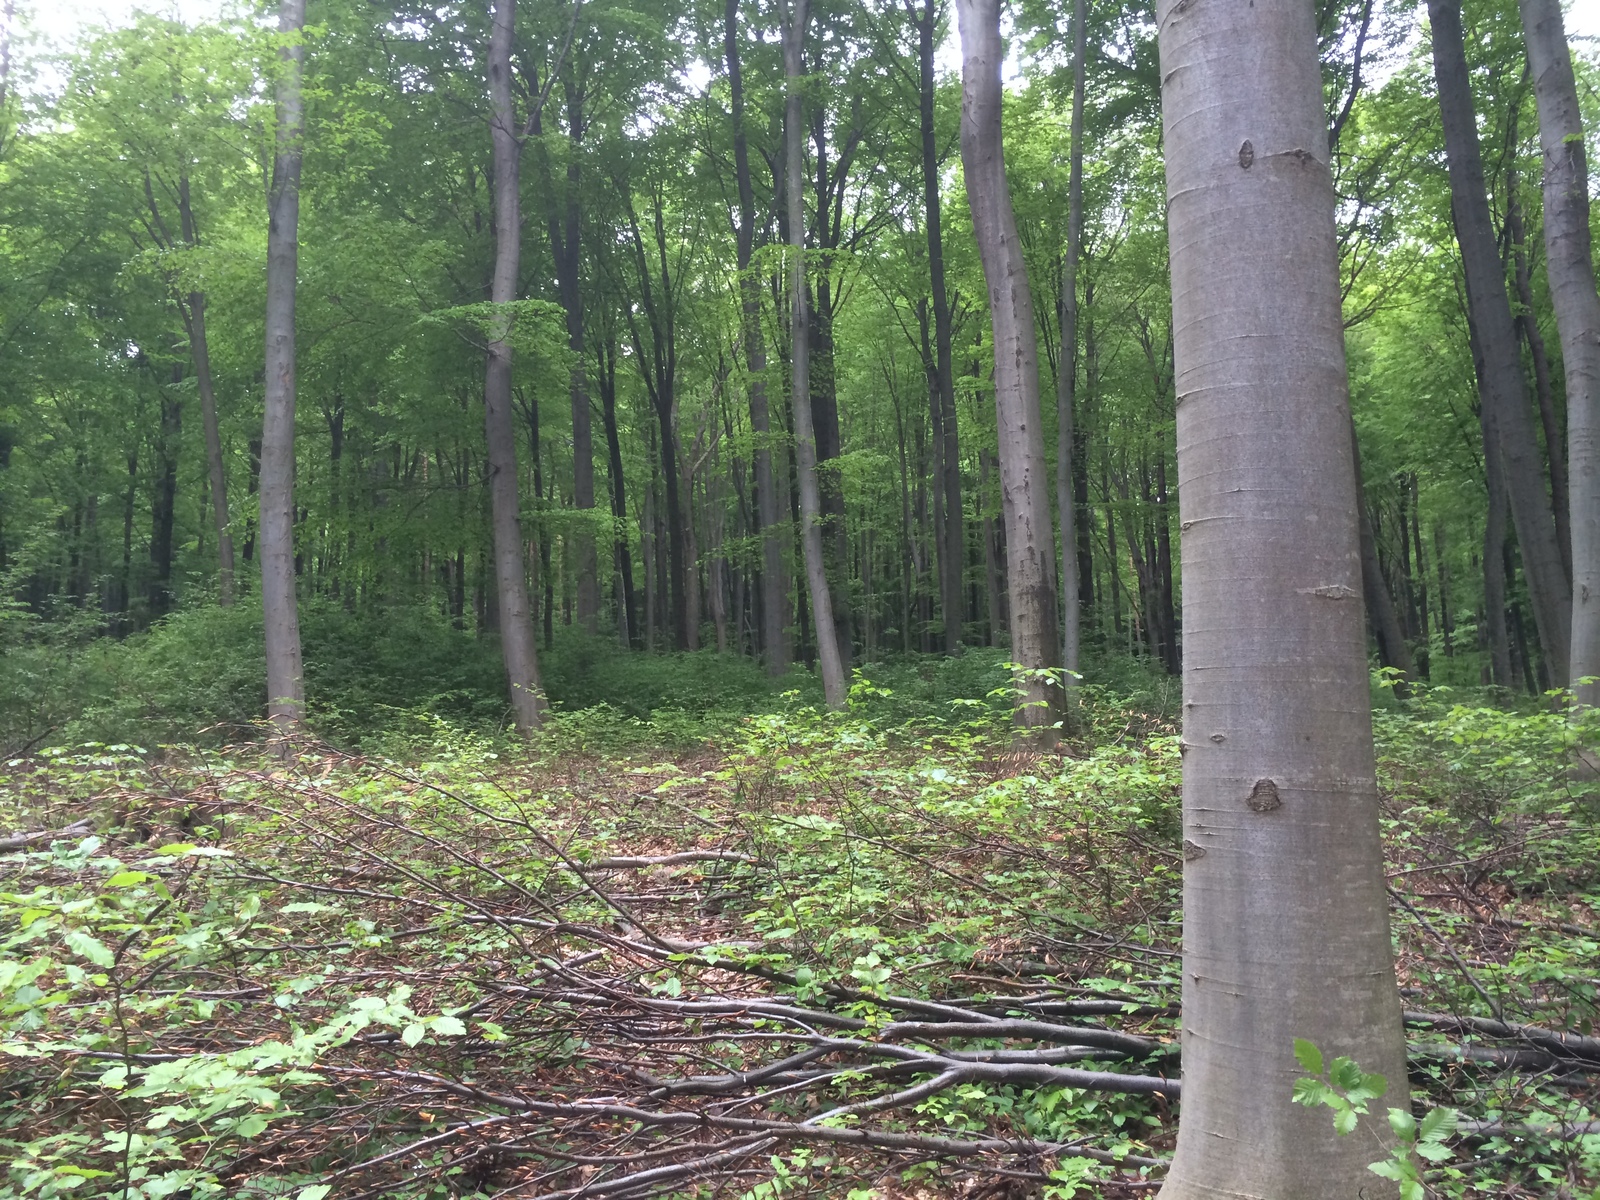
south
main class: Woodland
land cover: Broadleaved woodland
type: beech forest
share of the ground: > 75 %
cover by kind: broadleaved forest trees 100 %
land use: Forestry
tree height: > 5 m
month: May
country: AT
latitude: 48.0497
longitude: 16.1885
